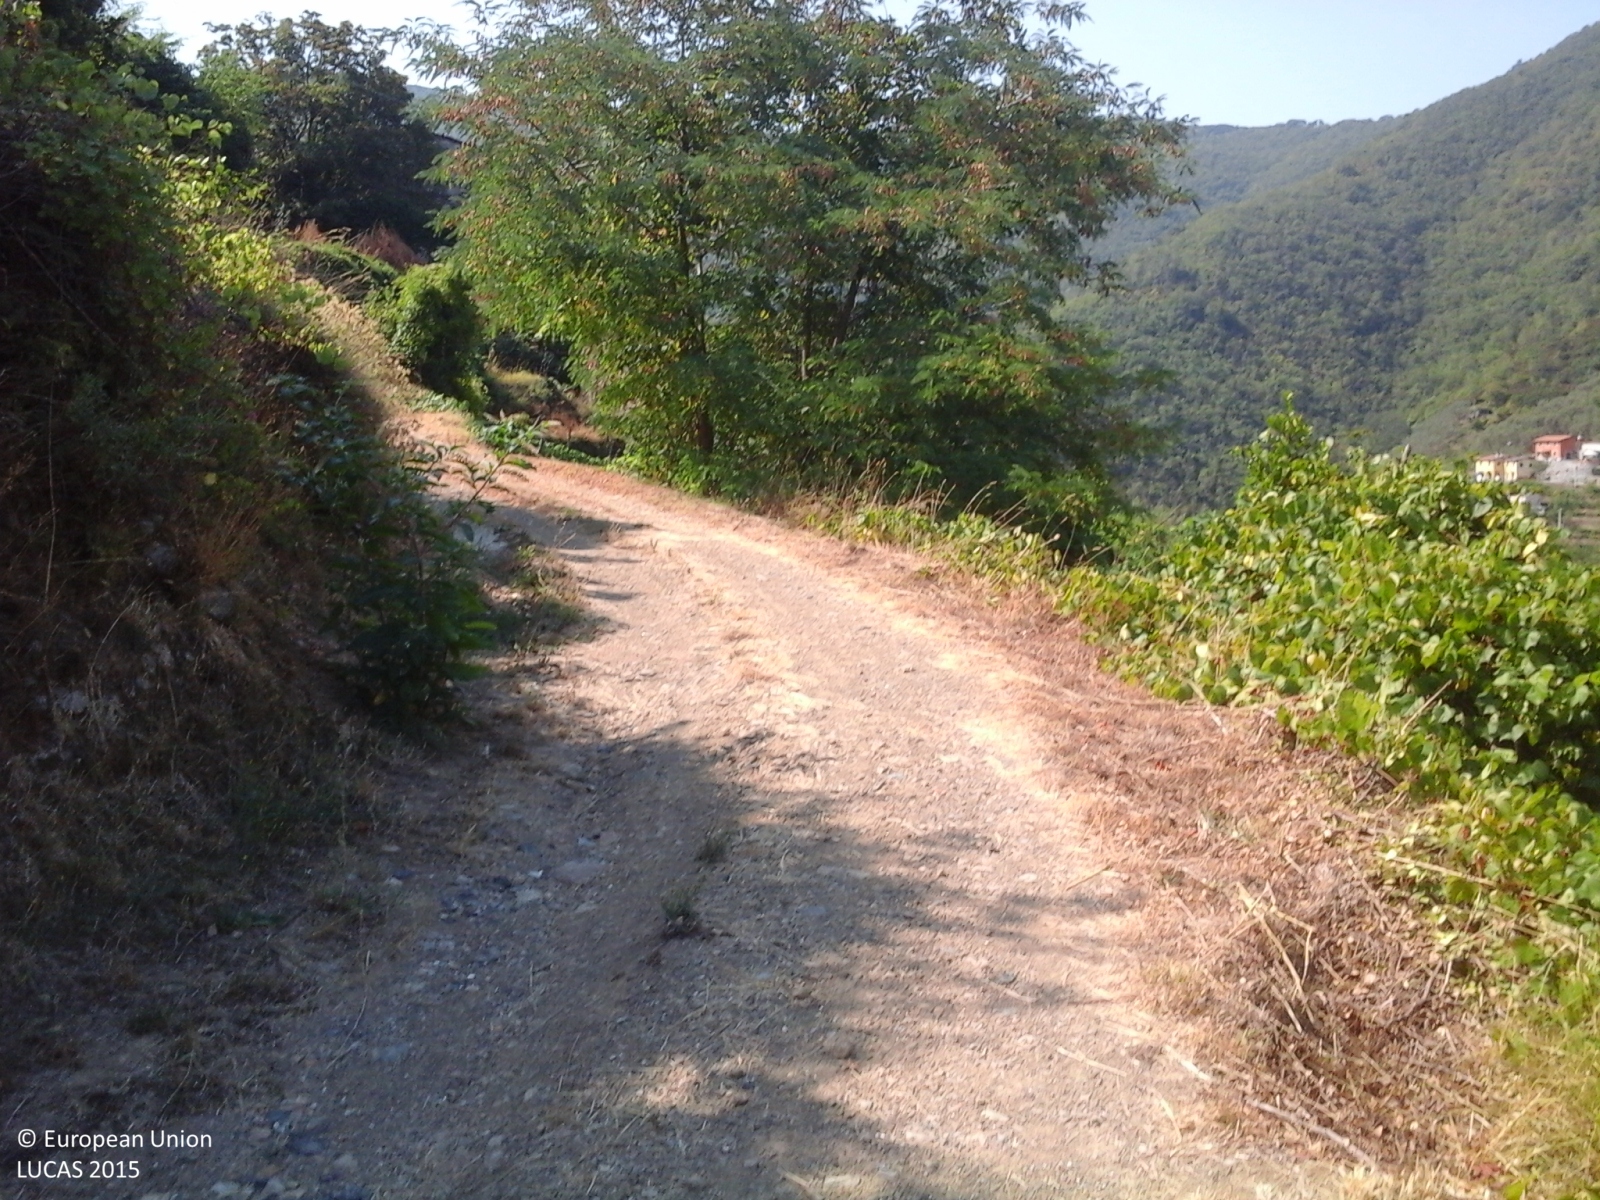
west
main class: Cropland
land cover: Olive groves
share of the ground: > 75 %
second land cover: Grassland without tree/shrub cover
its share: > 75 %
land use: Agriculture (excluding fallow land and kitchen gardens)
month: August
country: IT
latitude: 44.3308
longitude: 9.4120
